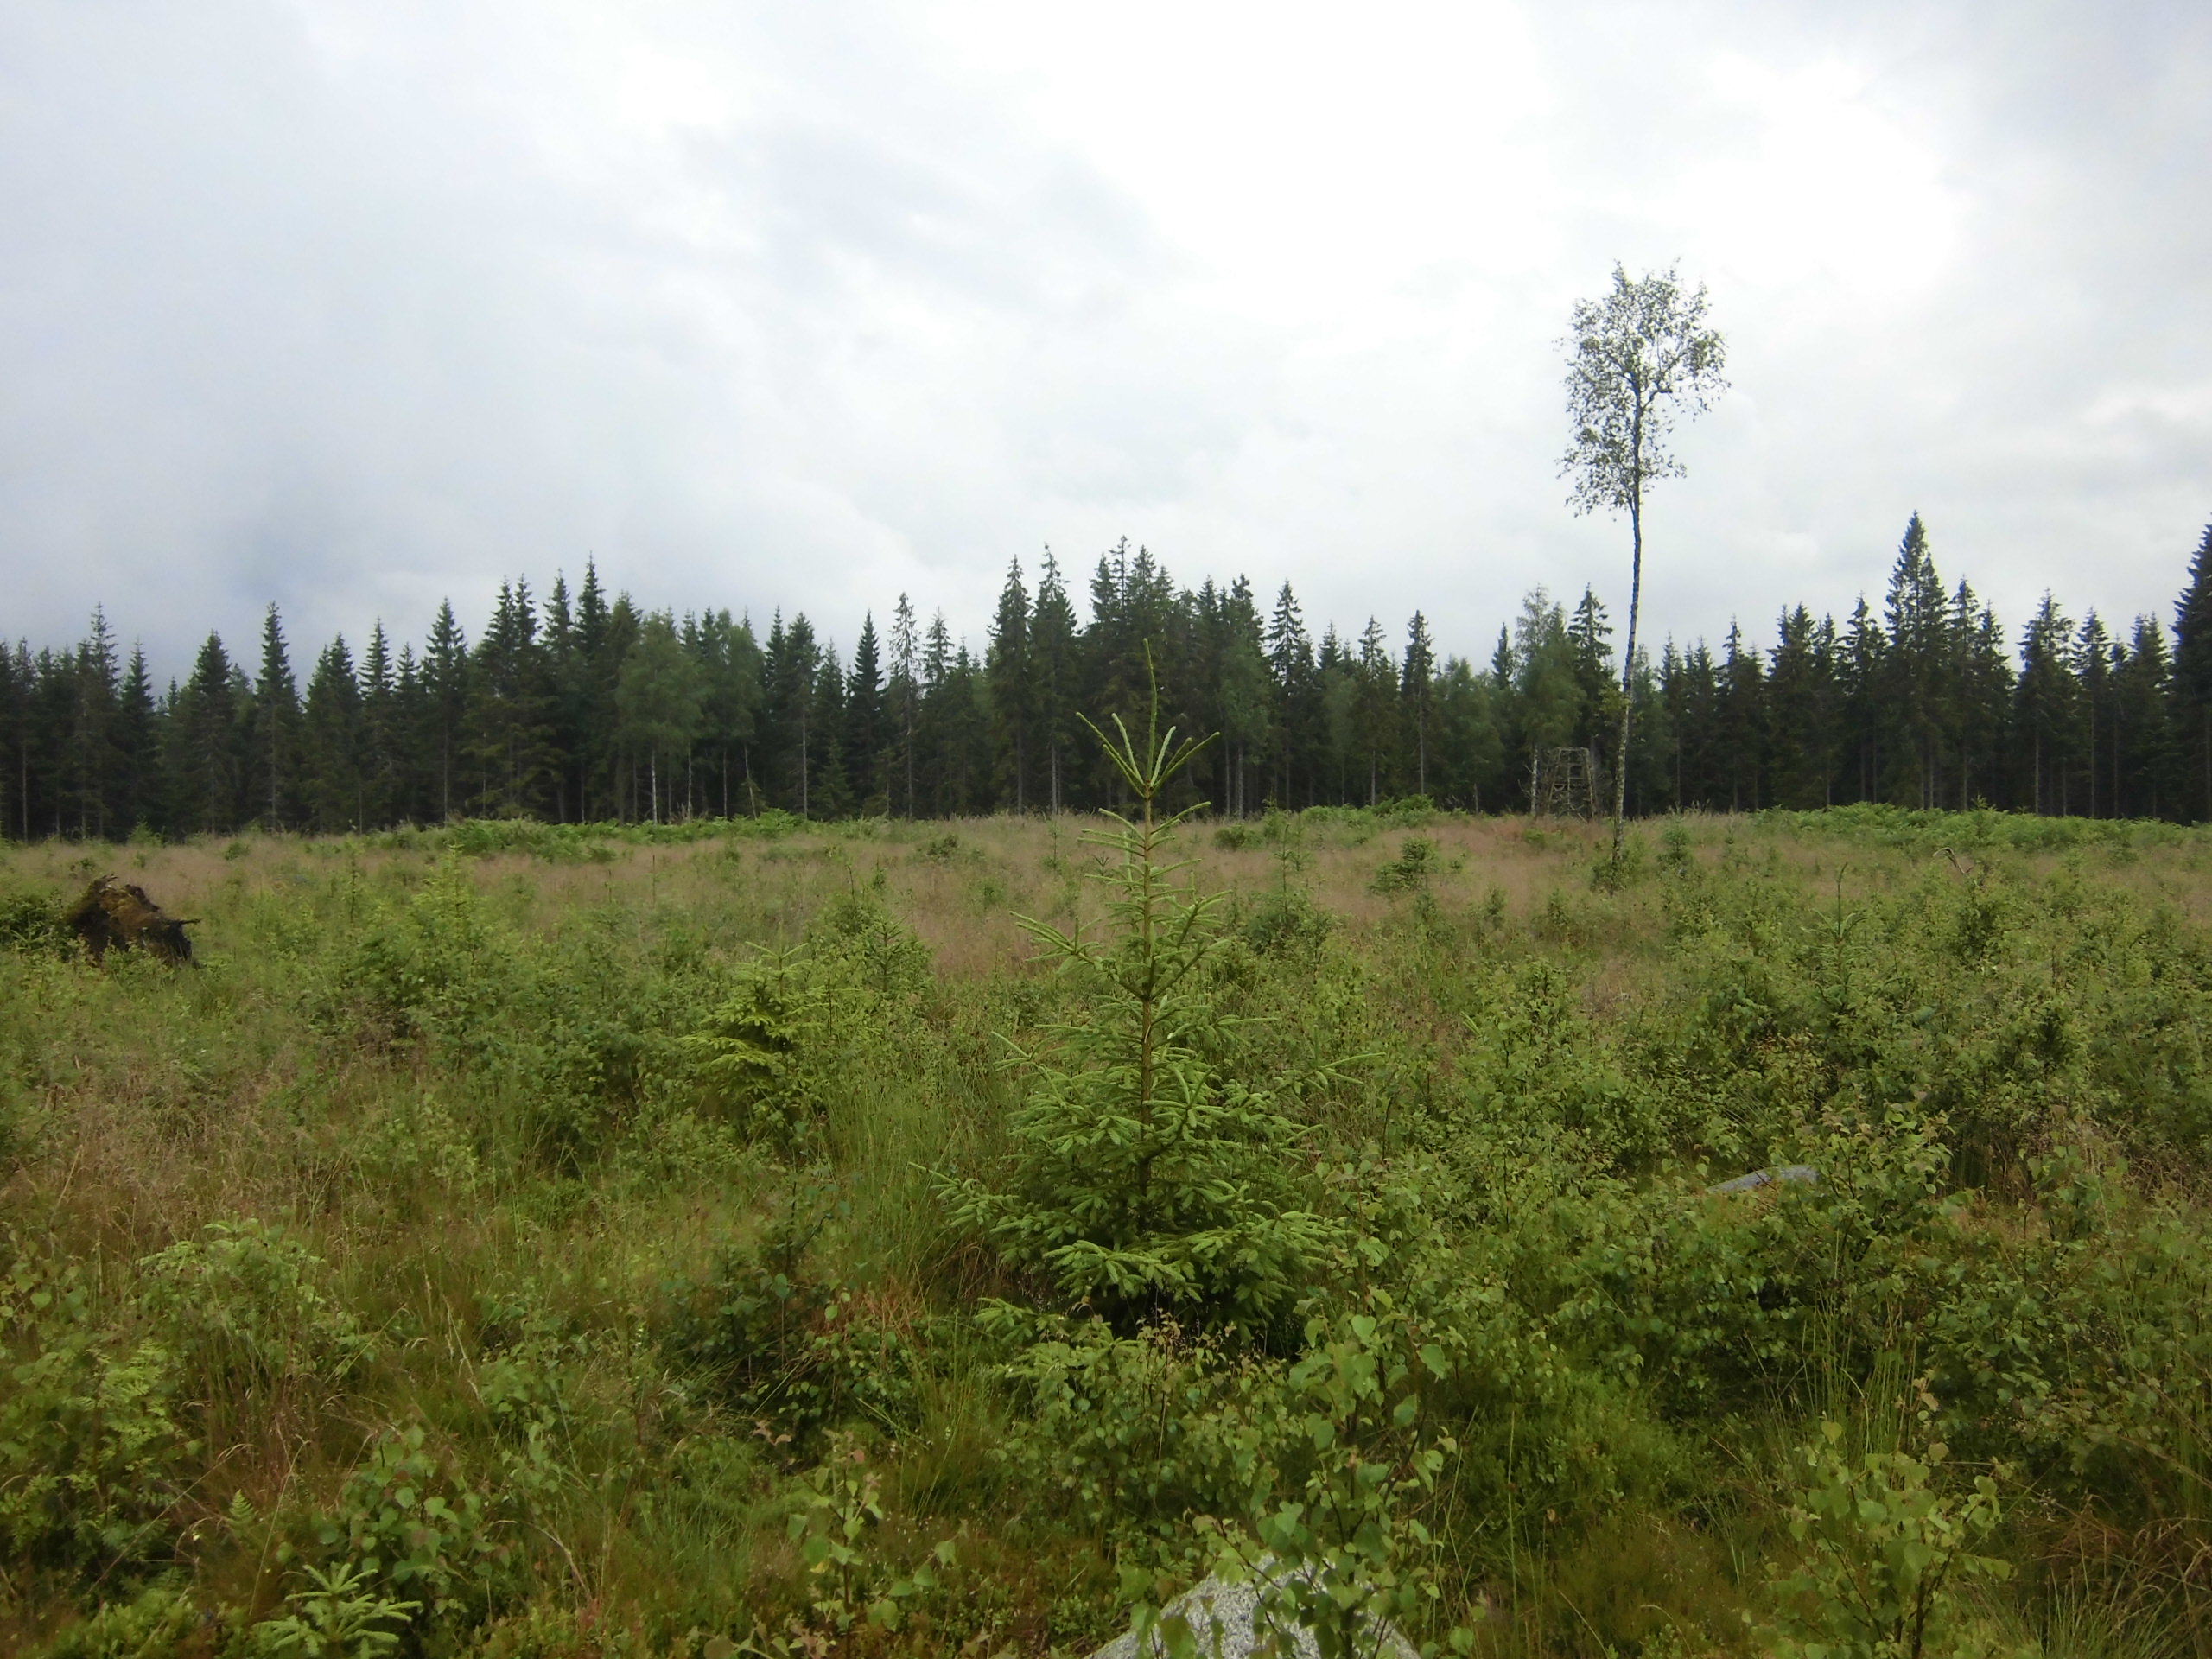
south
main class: Woodland
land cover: Spruce dominated mixed woodland
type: boreal forest
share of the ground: 50 - 75 %
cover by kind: broadleaved forest trees 35 %, coniferous forest trees 25 %, shrubs 20 %, herbaceous plants 20 %
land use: Forestry
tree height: < 5 m
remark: Clear cut
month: July
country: SE
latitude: 57.2556
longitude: 15.1521
